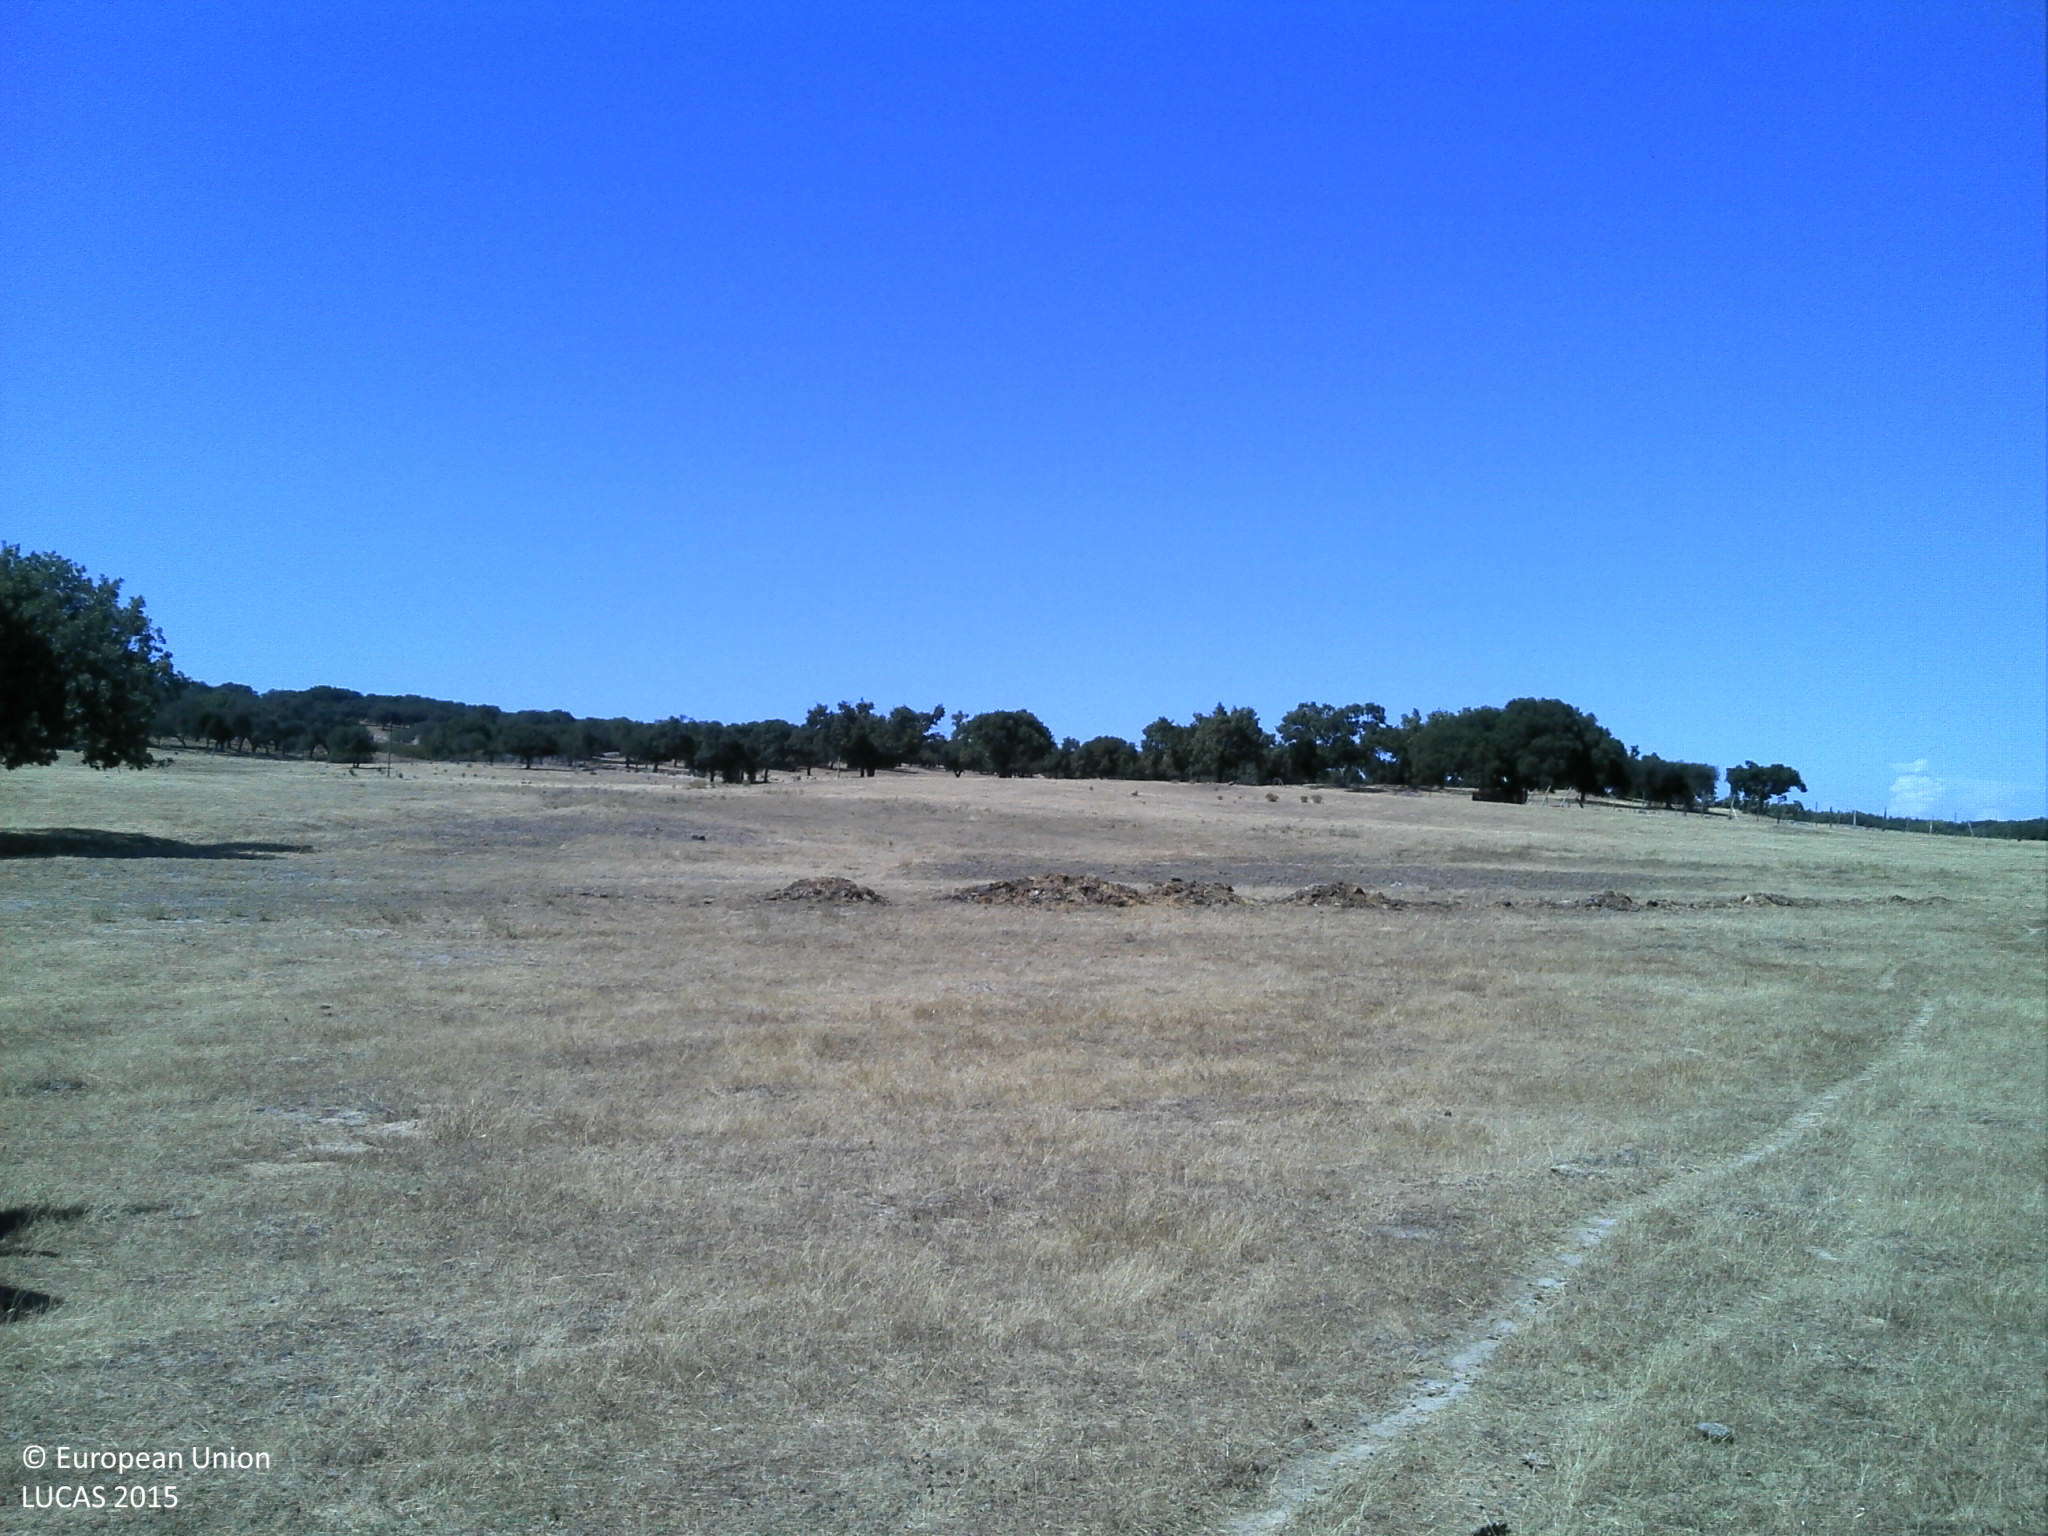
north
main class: Grassland
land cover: Grassland without tree/shrub cover
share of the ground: 10 - 25 %
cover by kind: unconsolidated bare surface 90 %, herbaceous plants 10 %
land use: Agriculture (excluding fallow land and kitchen gardens)
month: July
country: PT
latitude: 39.3584
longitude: -7.6296
